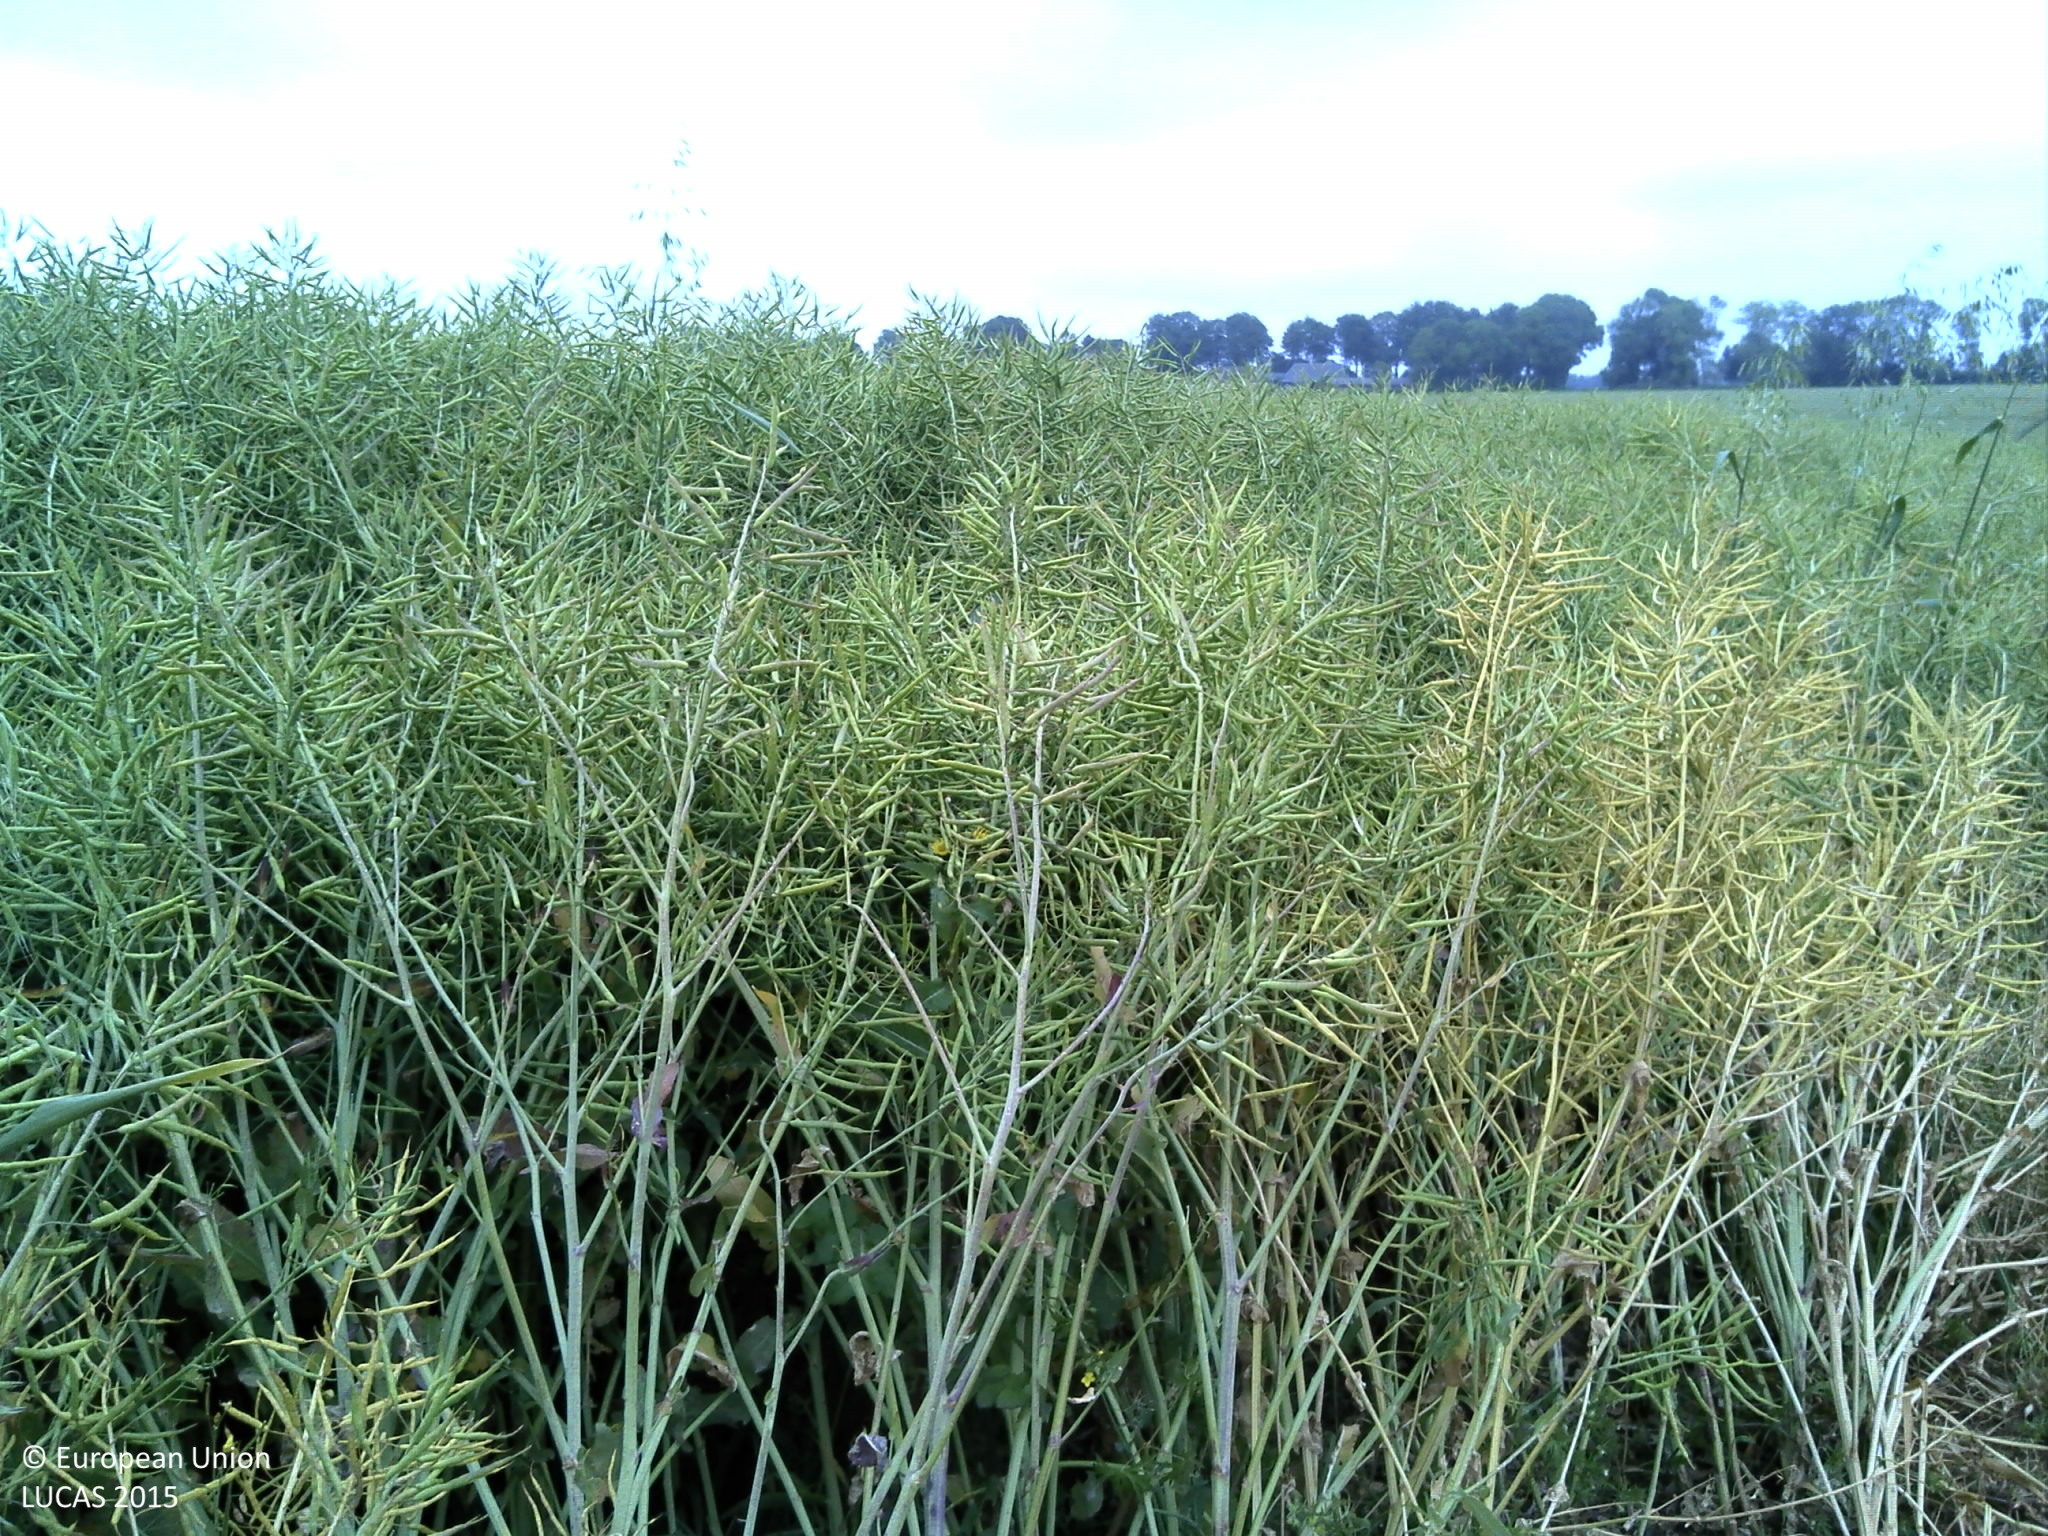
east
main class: Cropland
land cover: Rape and turnip rape
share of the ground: > 75 %
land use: Agriculture (excluding fallow land and kitchen gardens)
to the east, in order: Rape and turnip rape; Grassland without tree/shrub cover; Common wheat
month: June
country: FR
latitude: 49.6624
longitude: 0.3151
